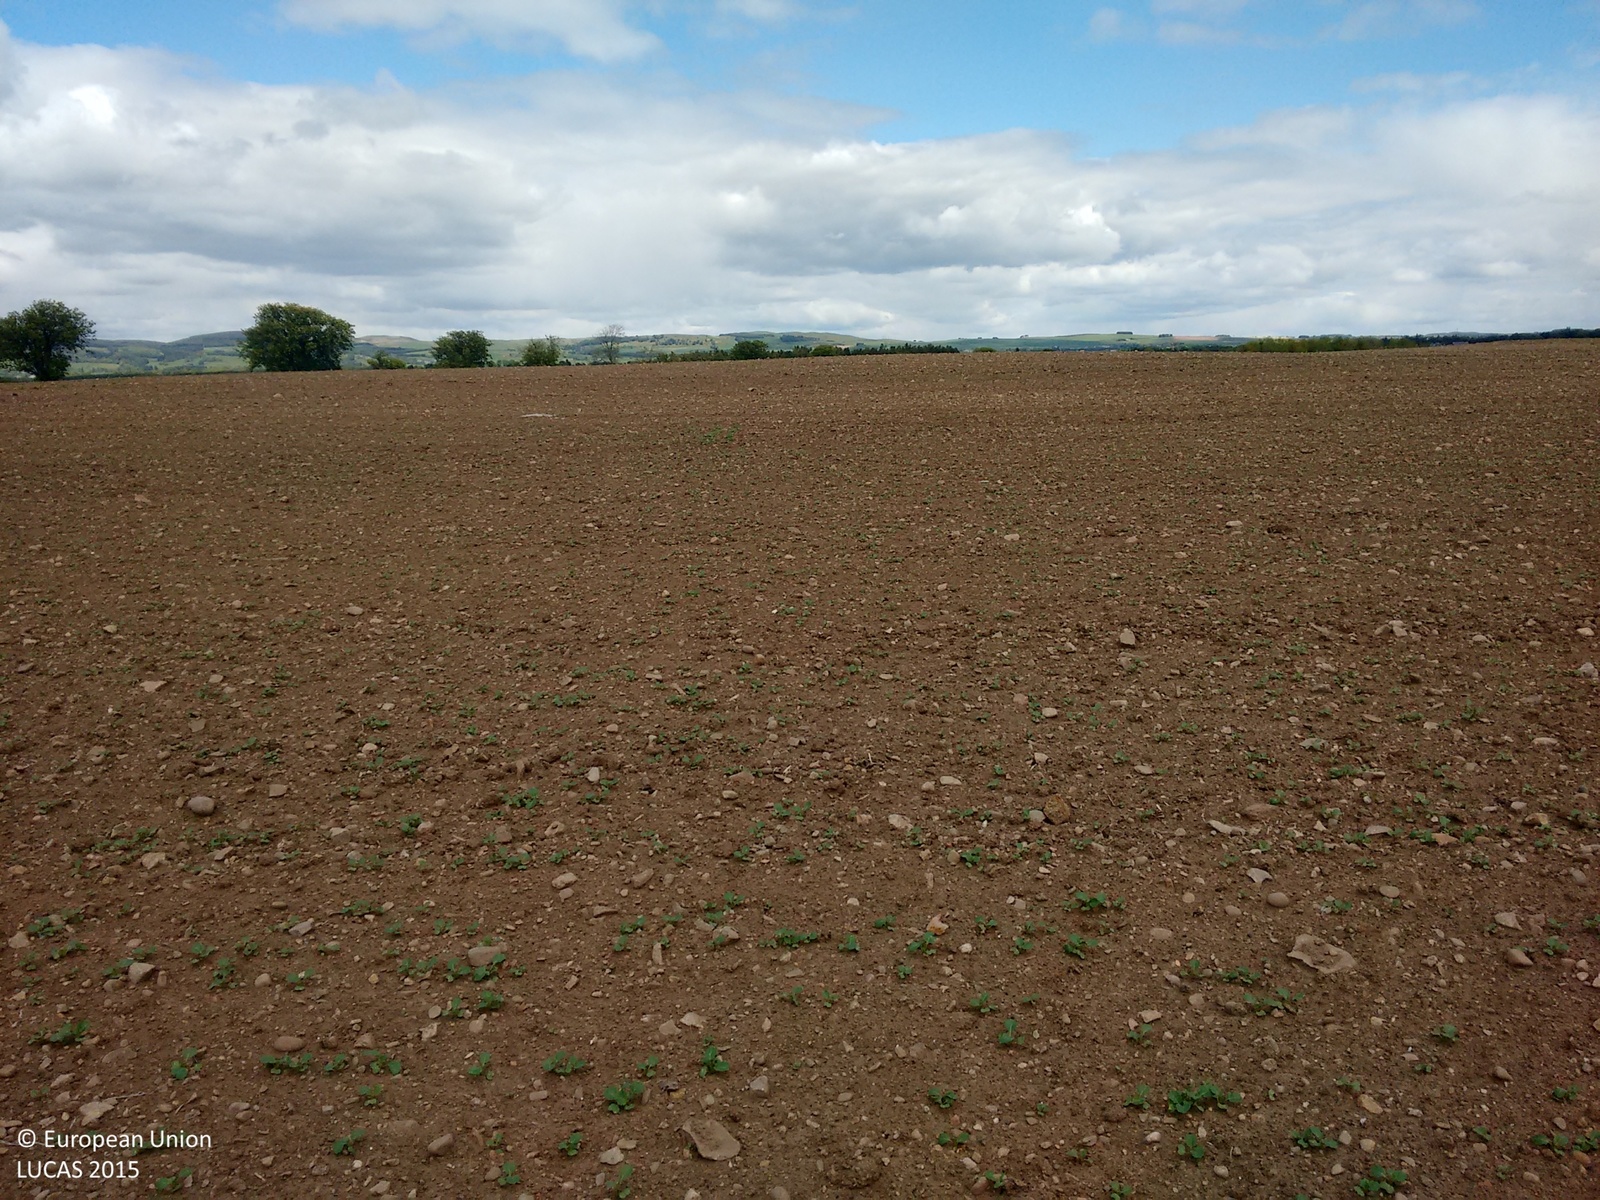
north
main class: Cropland
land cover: Rape and turnip rape
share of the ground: 10 - 25 %
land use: Agriculture (excluding fallow land and kitchen gardens)
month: June
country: GB
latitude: 56.1892
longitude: -3.4333
